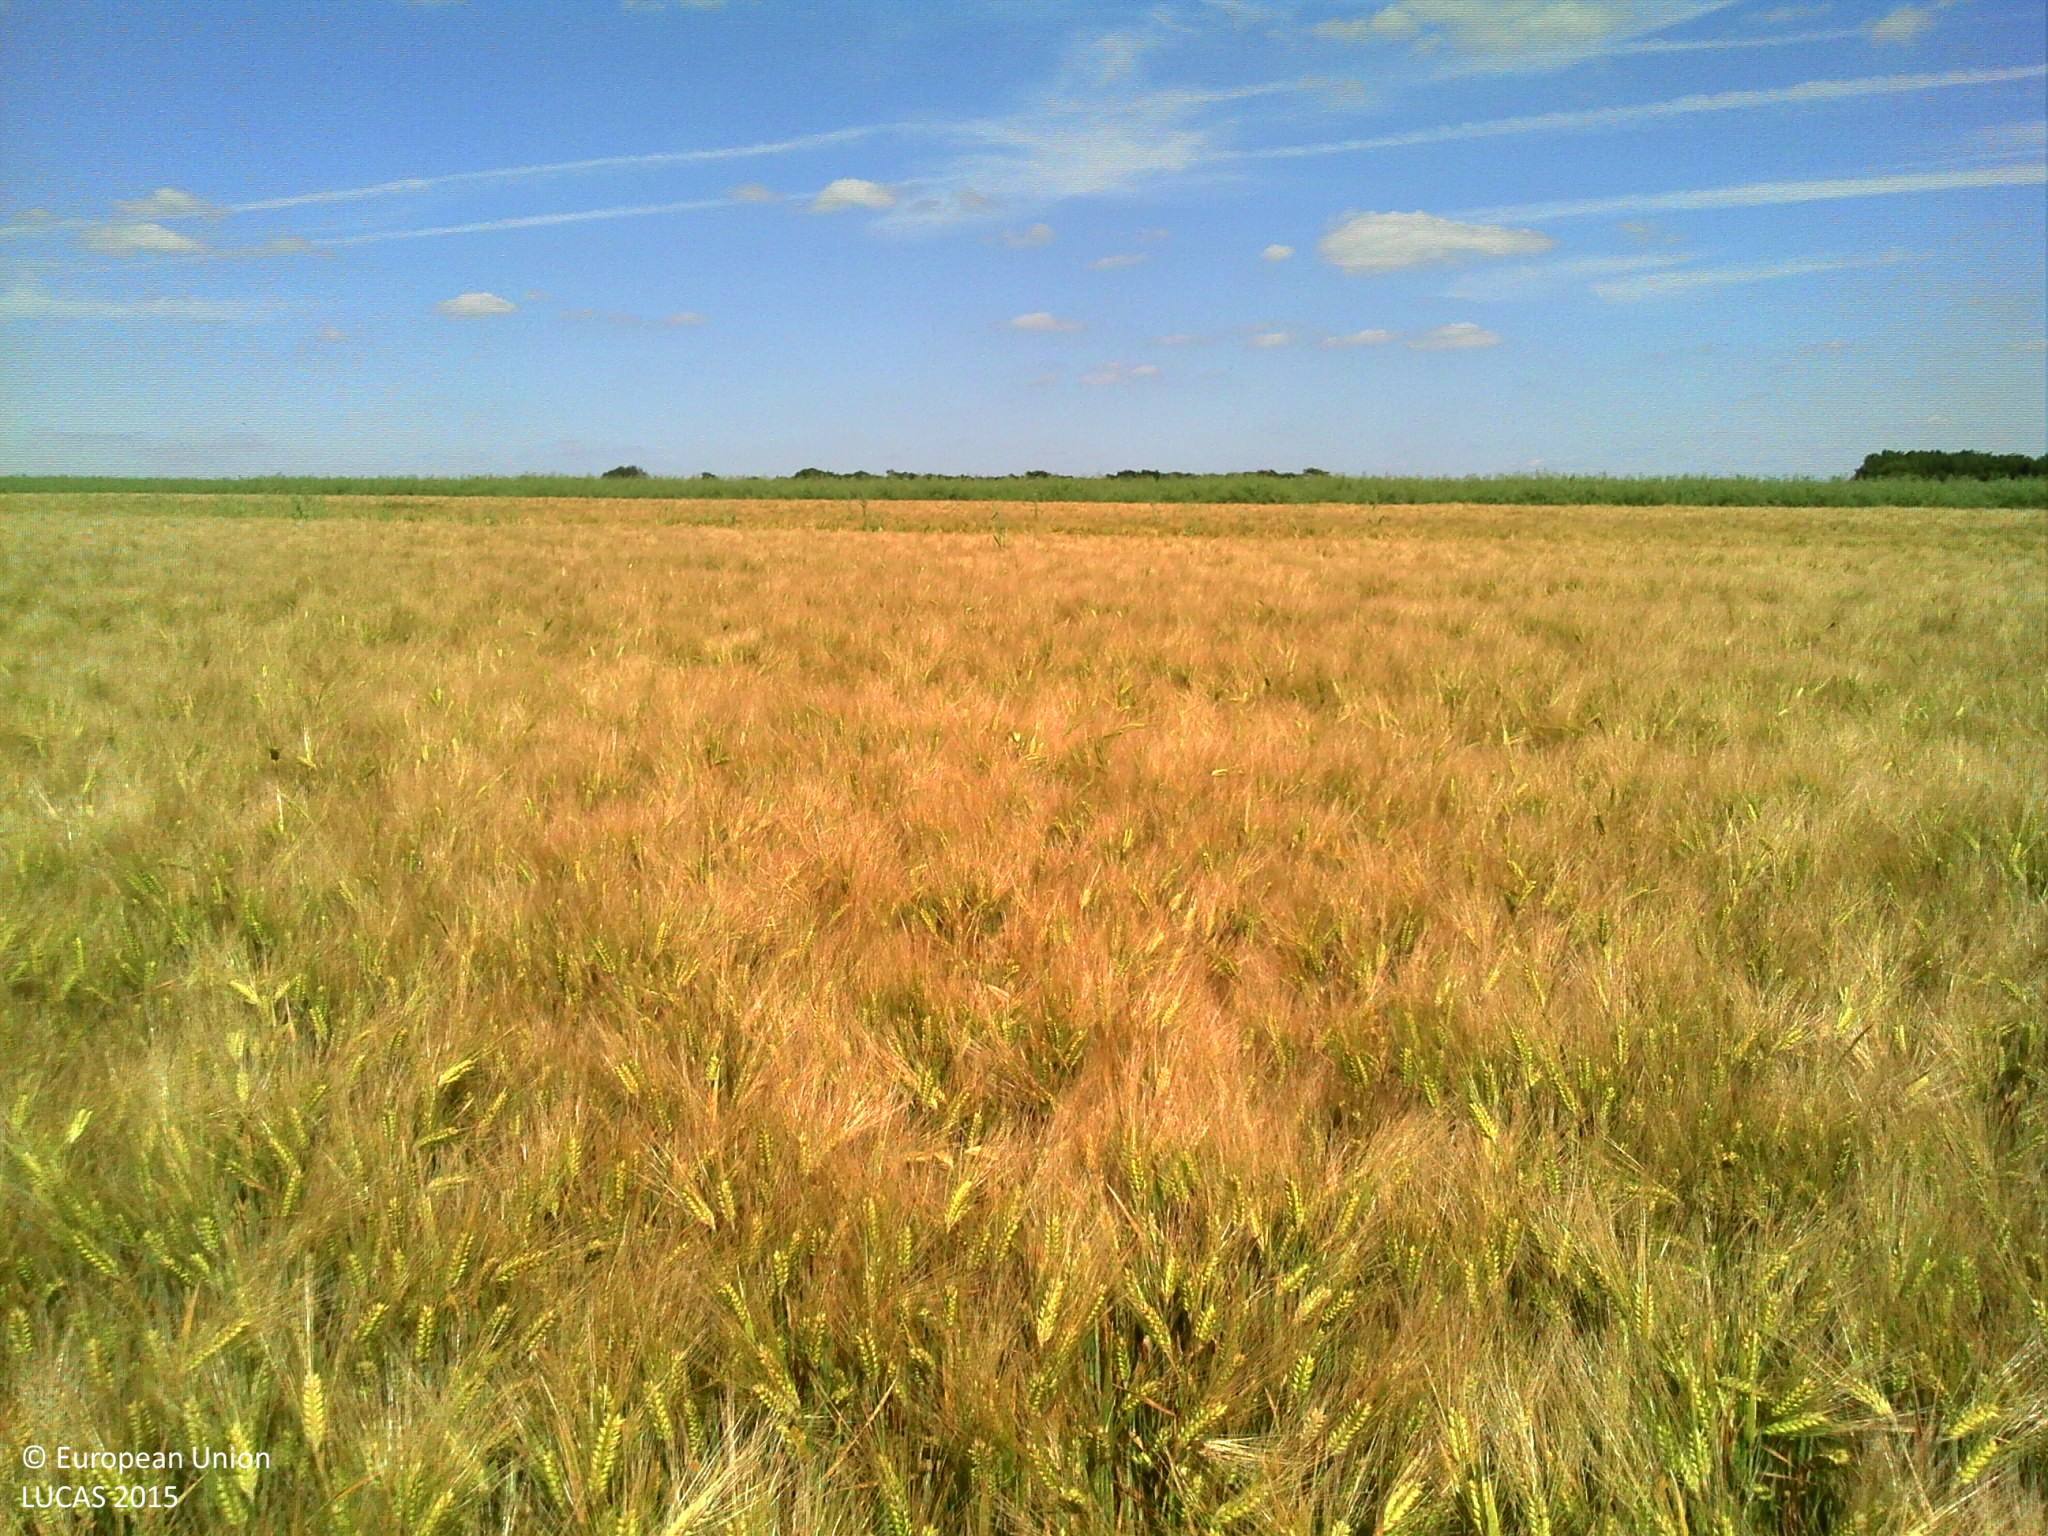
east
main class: Cropland
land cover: Barley
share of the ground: > 75 %
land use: Agriculture (excluding fallow land and kitchen gardens)
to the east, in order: Barley; Rape and turnip rape; Other non-permanent industrial crops; Barley
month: May
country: FR
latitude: 46.9891
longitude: 0.2087
